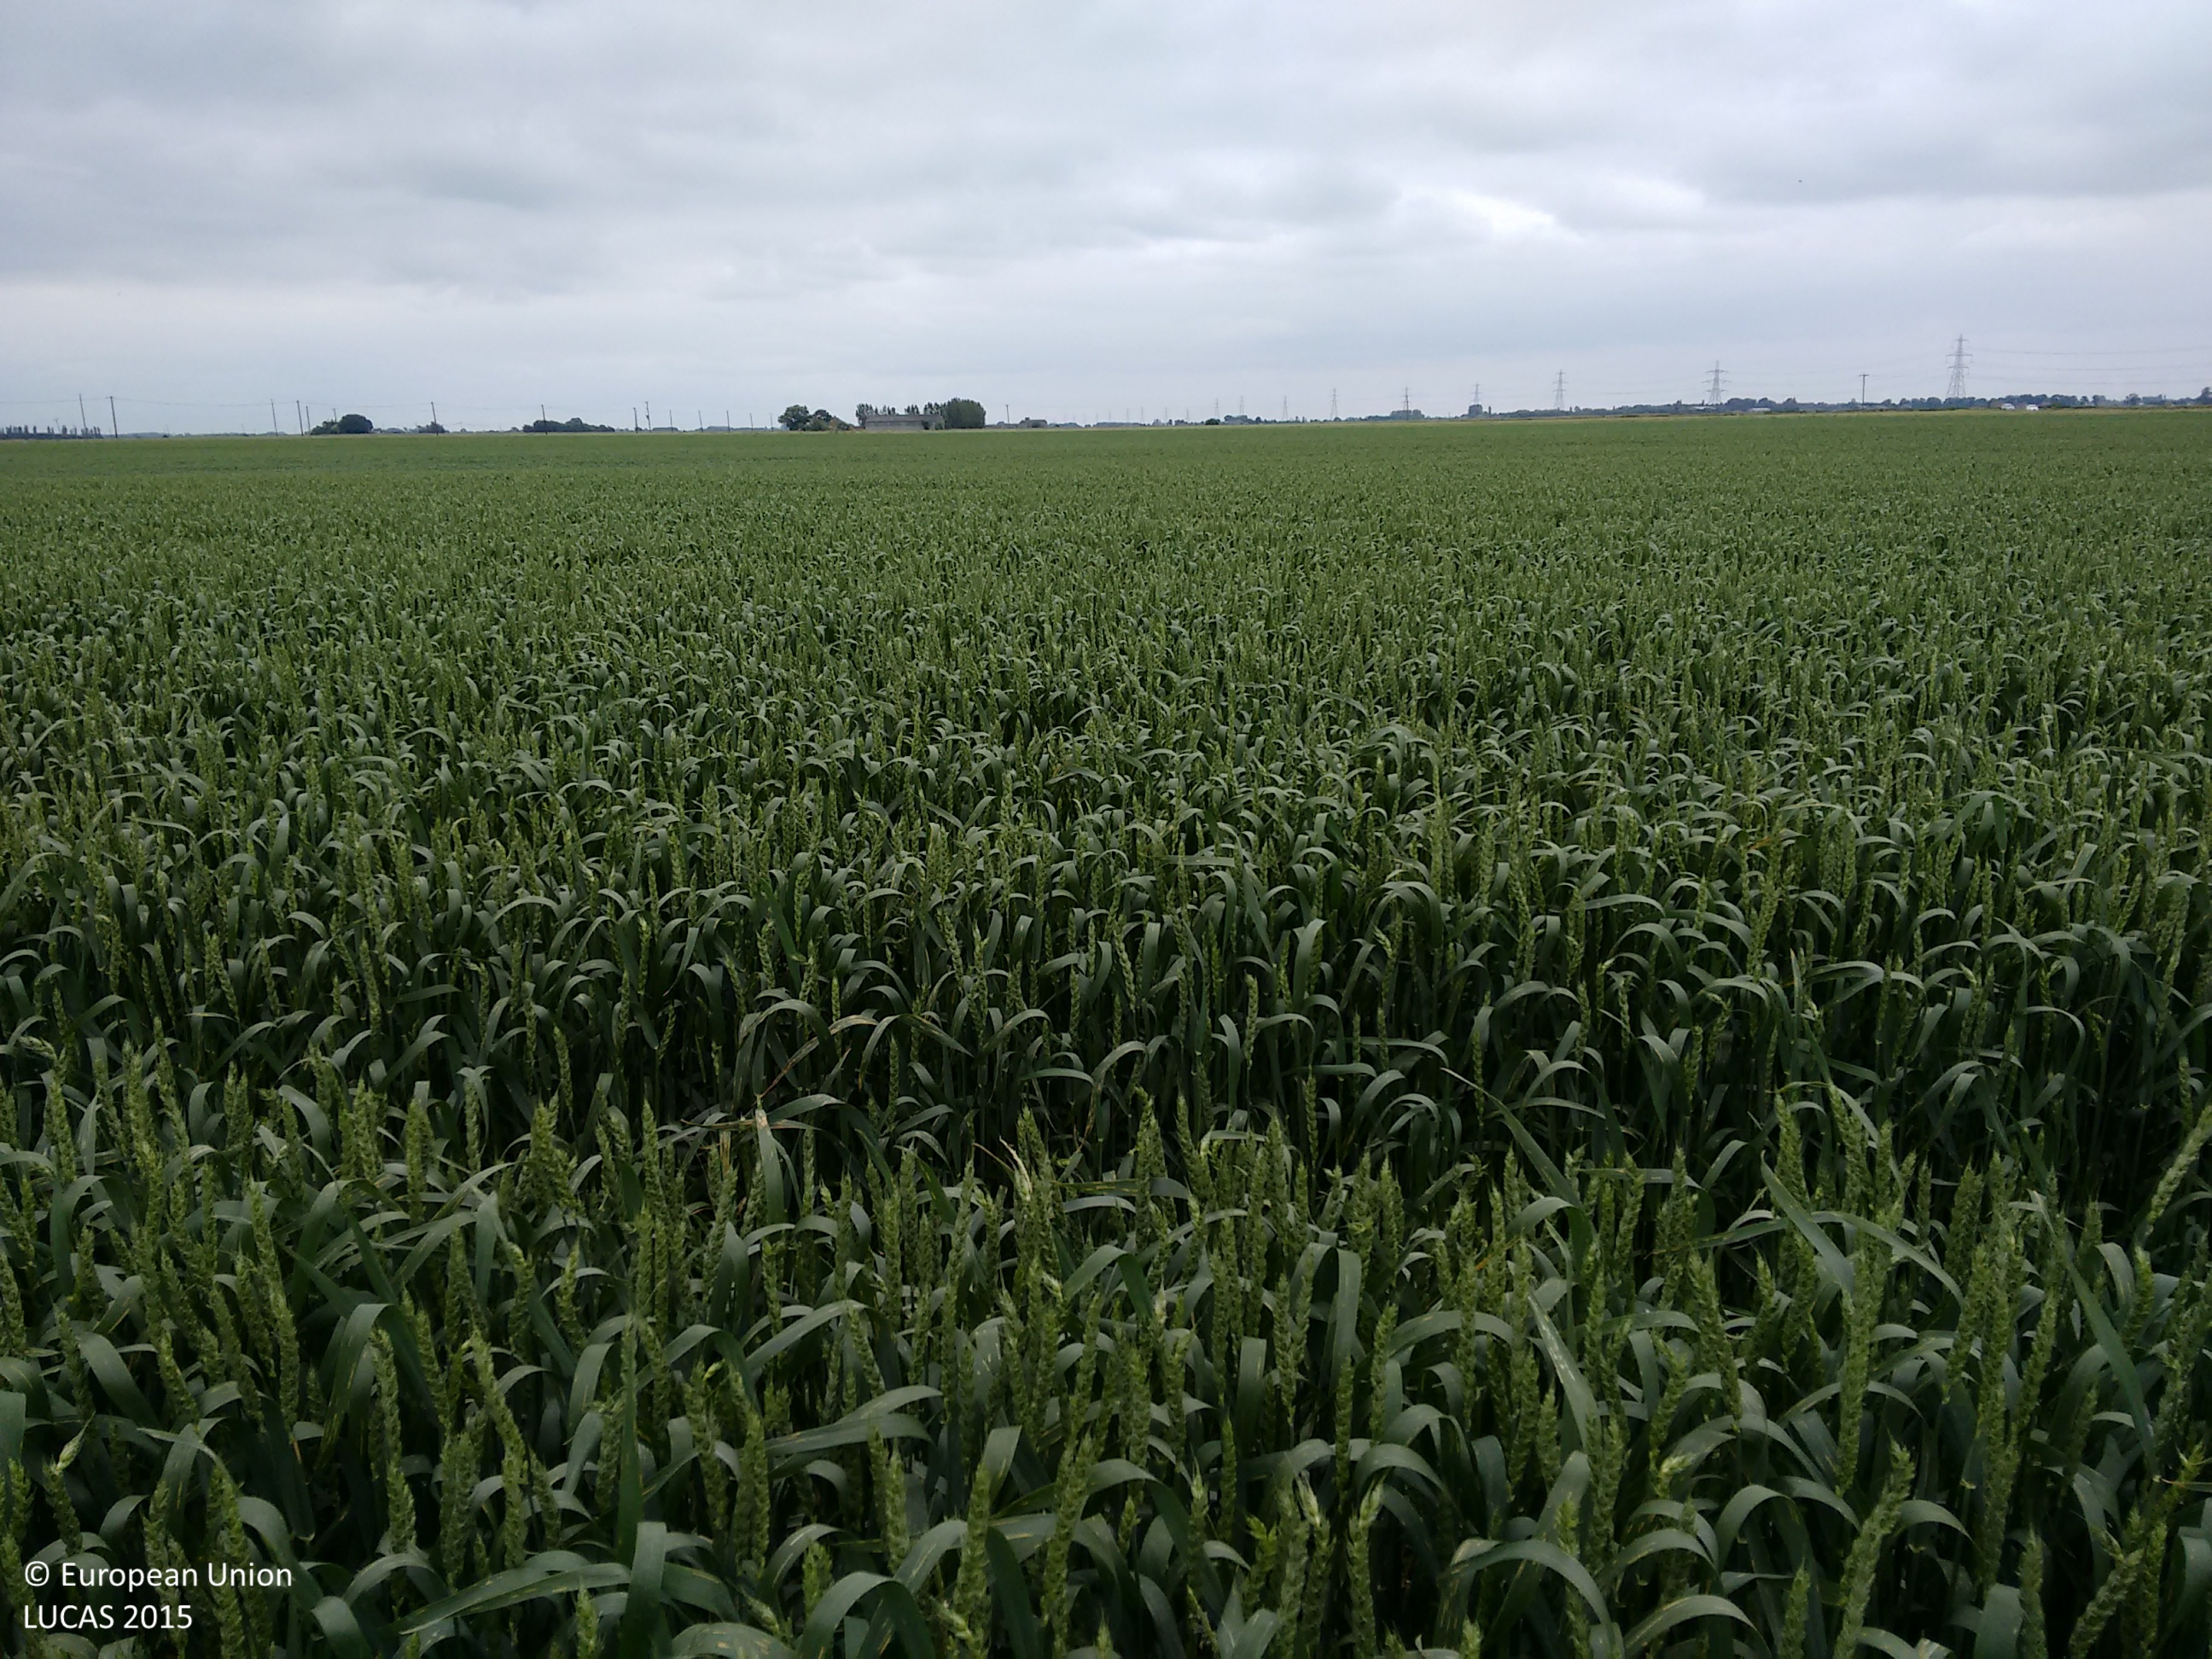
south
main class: Cropland
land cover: Common wheat
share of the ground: > 75 %
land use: Agriculture (excluding fallow land and kitchen gardens)
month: June
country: GB
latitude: 52.6462
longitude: 0.2598
